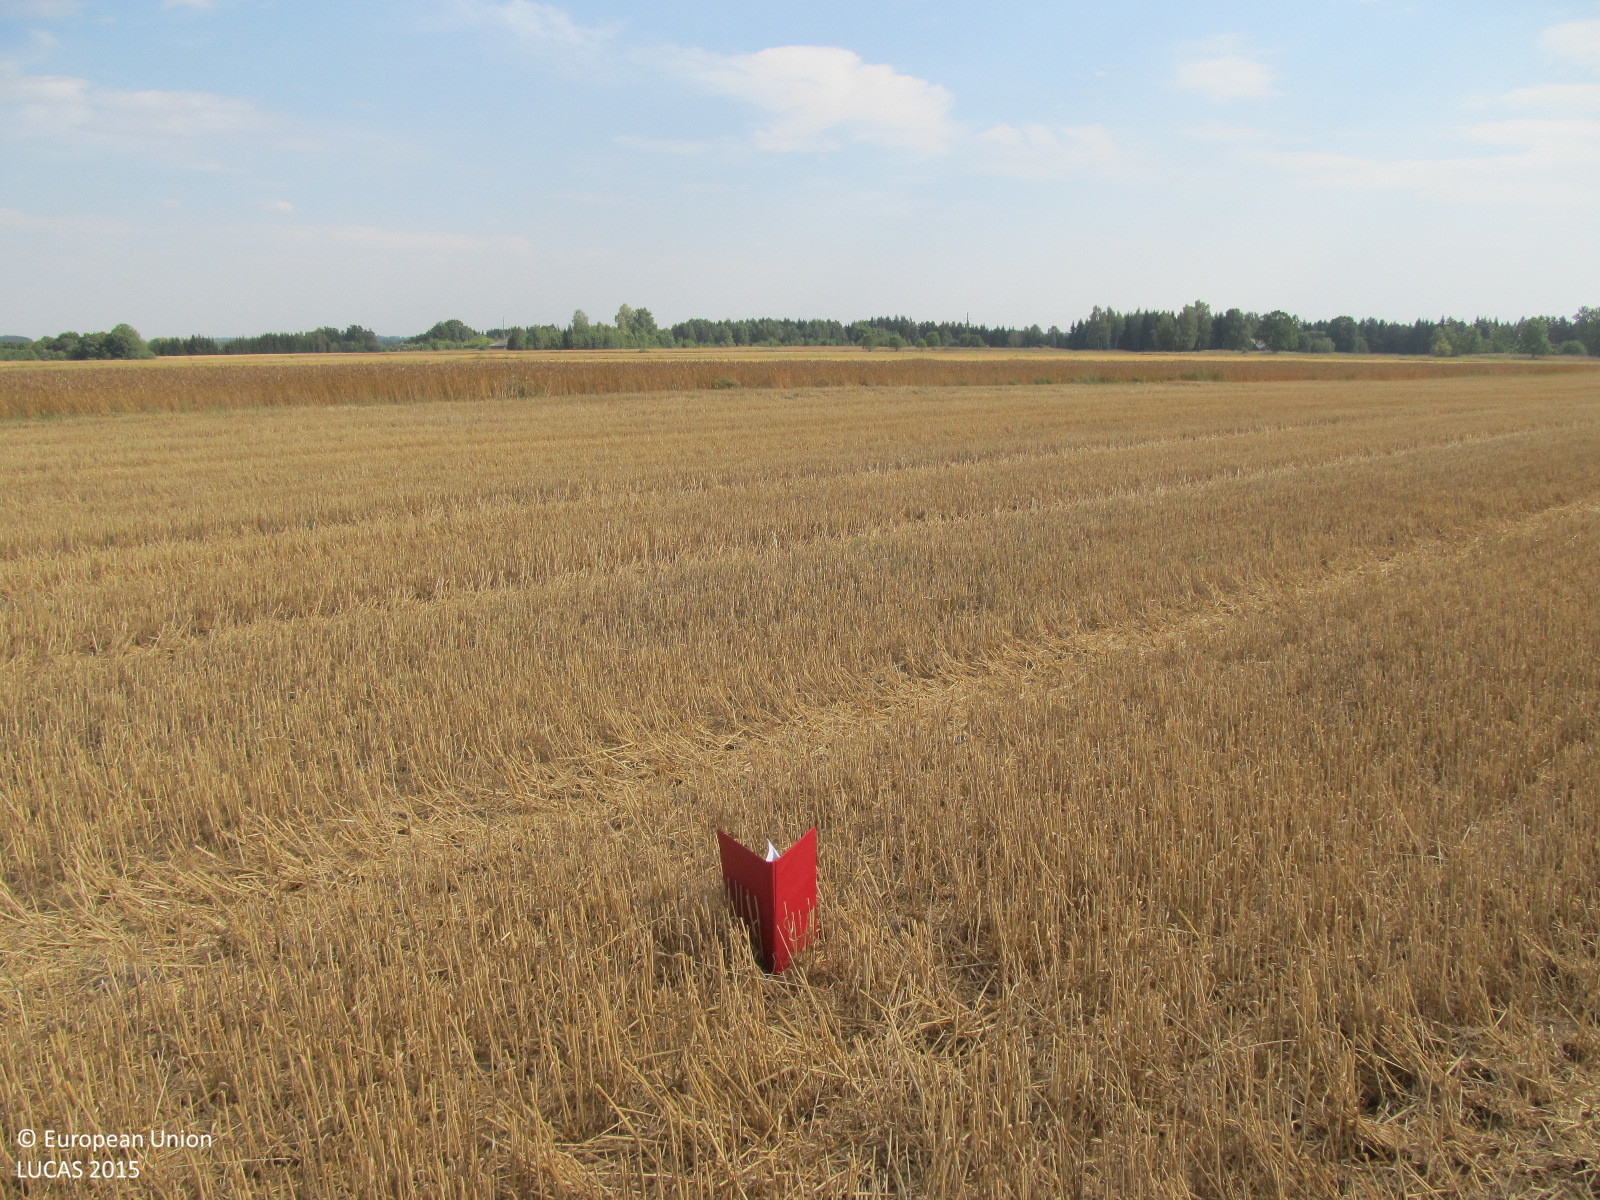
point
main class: Cropland
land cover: Barley
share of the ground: > 75 %
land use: Agriculture (excluding fallow land and kitchen gardens)
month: August
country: LT
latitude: 55.6627
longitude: 23.0575
